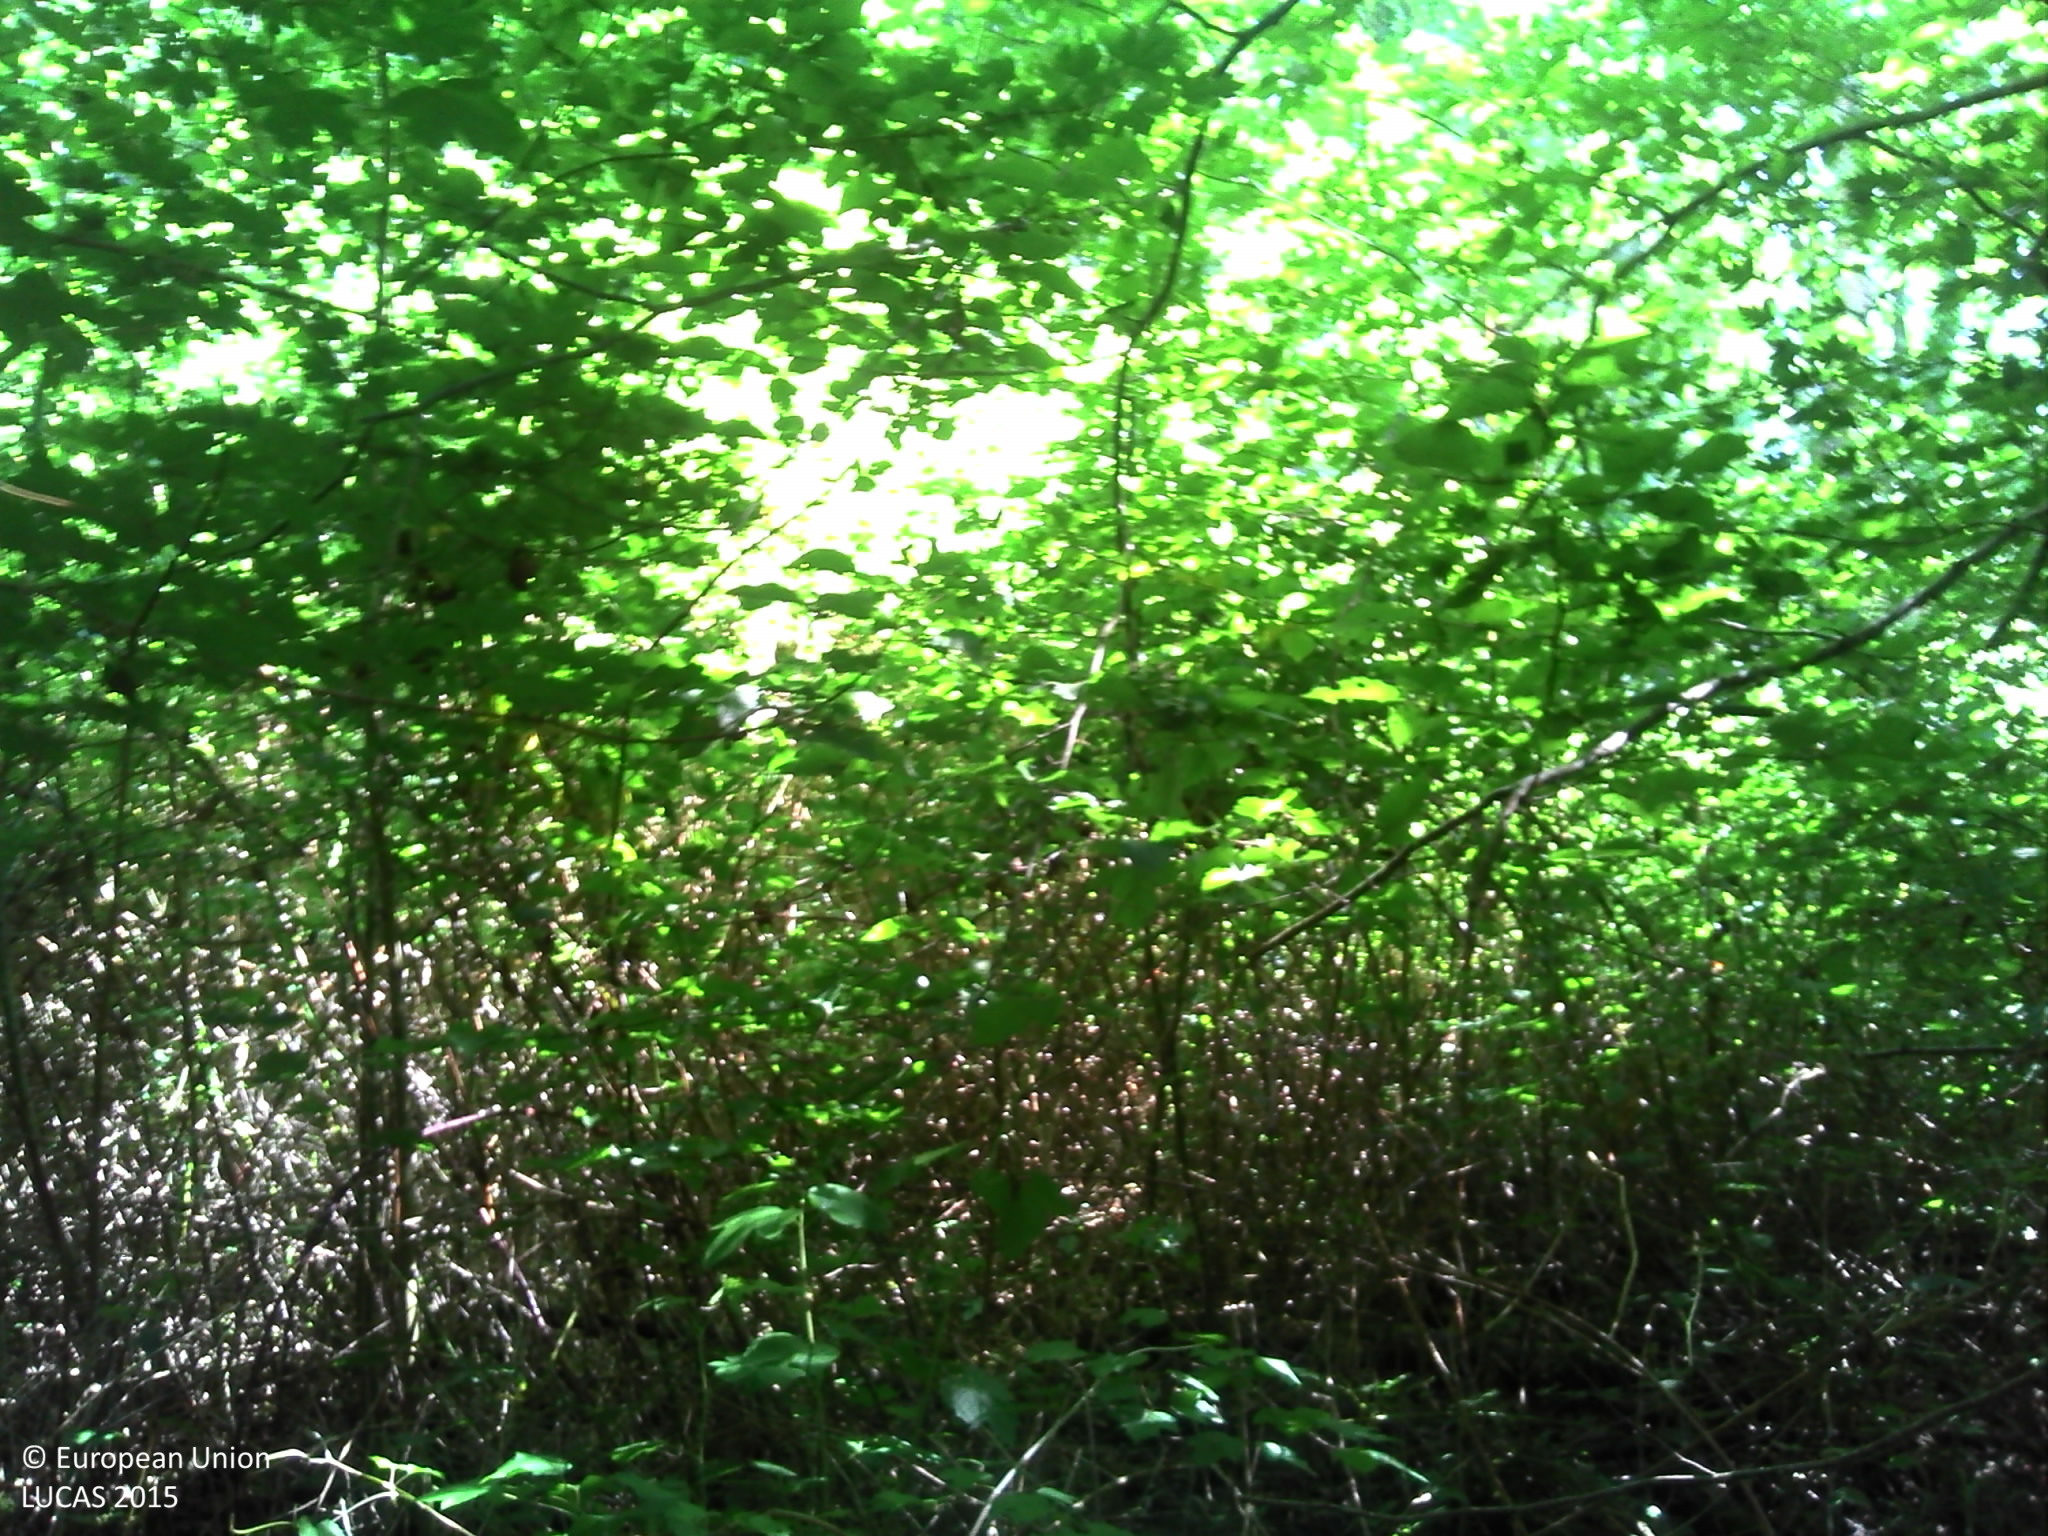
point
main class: Woodland
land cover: Broadleaved woodland
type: acidophilous oak and oak-birch forest
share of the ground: > 75 %
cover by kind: broadleaved forest trees 100 %
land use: Forestry
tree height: > 5 m
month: June
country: FR
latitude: 47.5744
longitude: 2.5607
